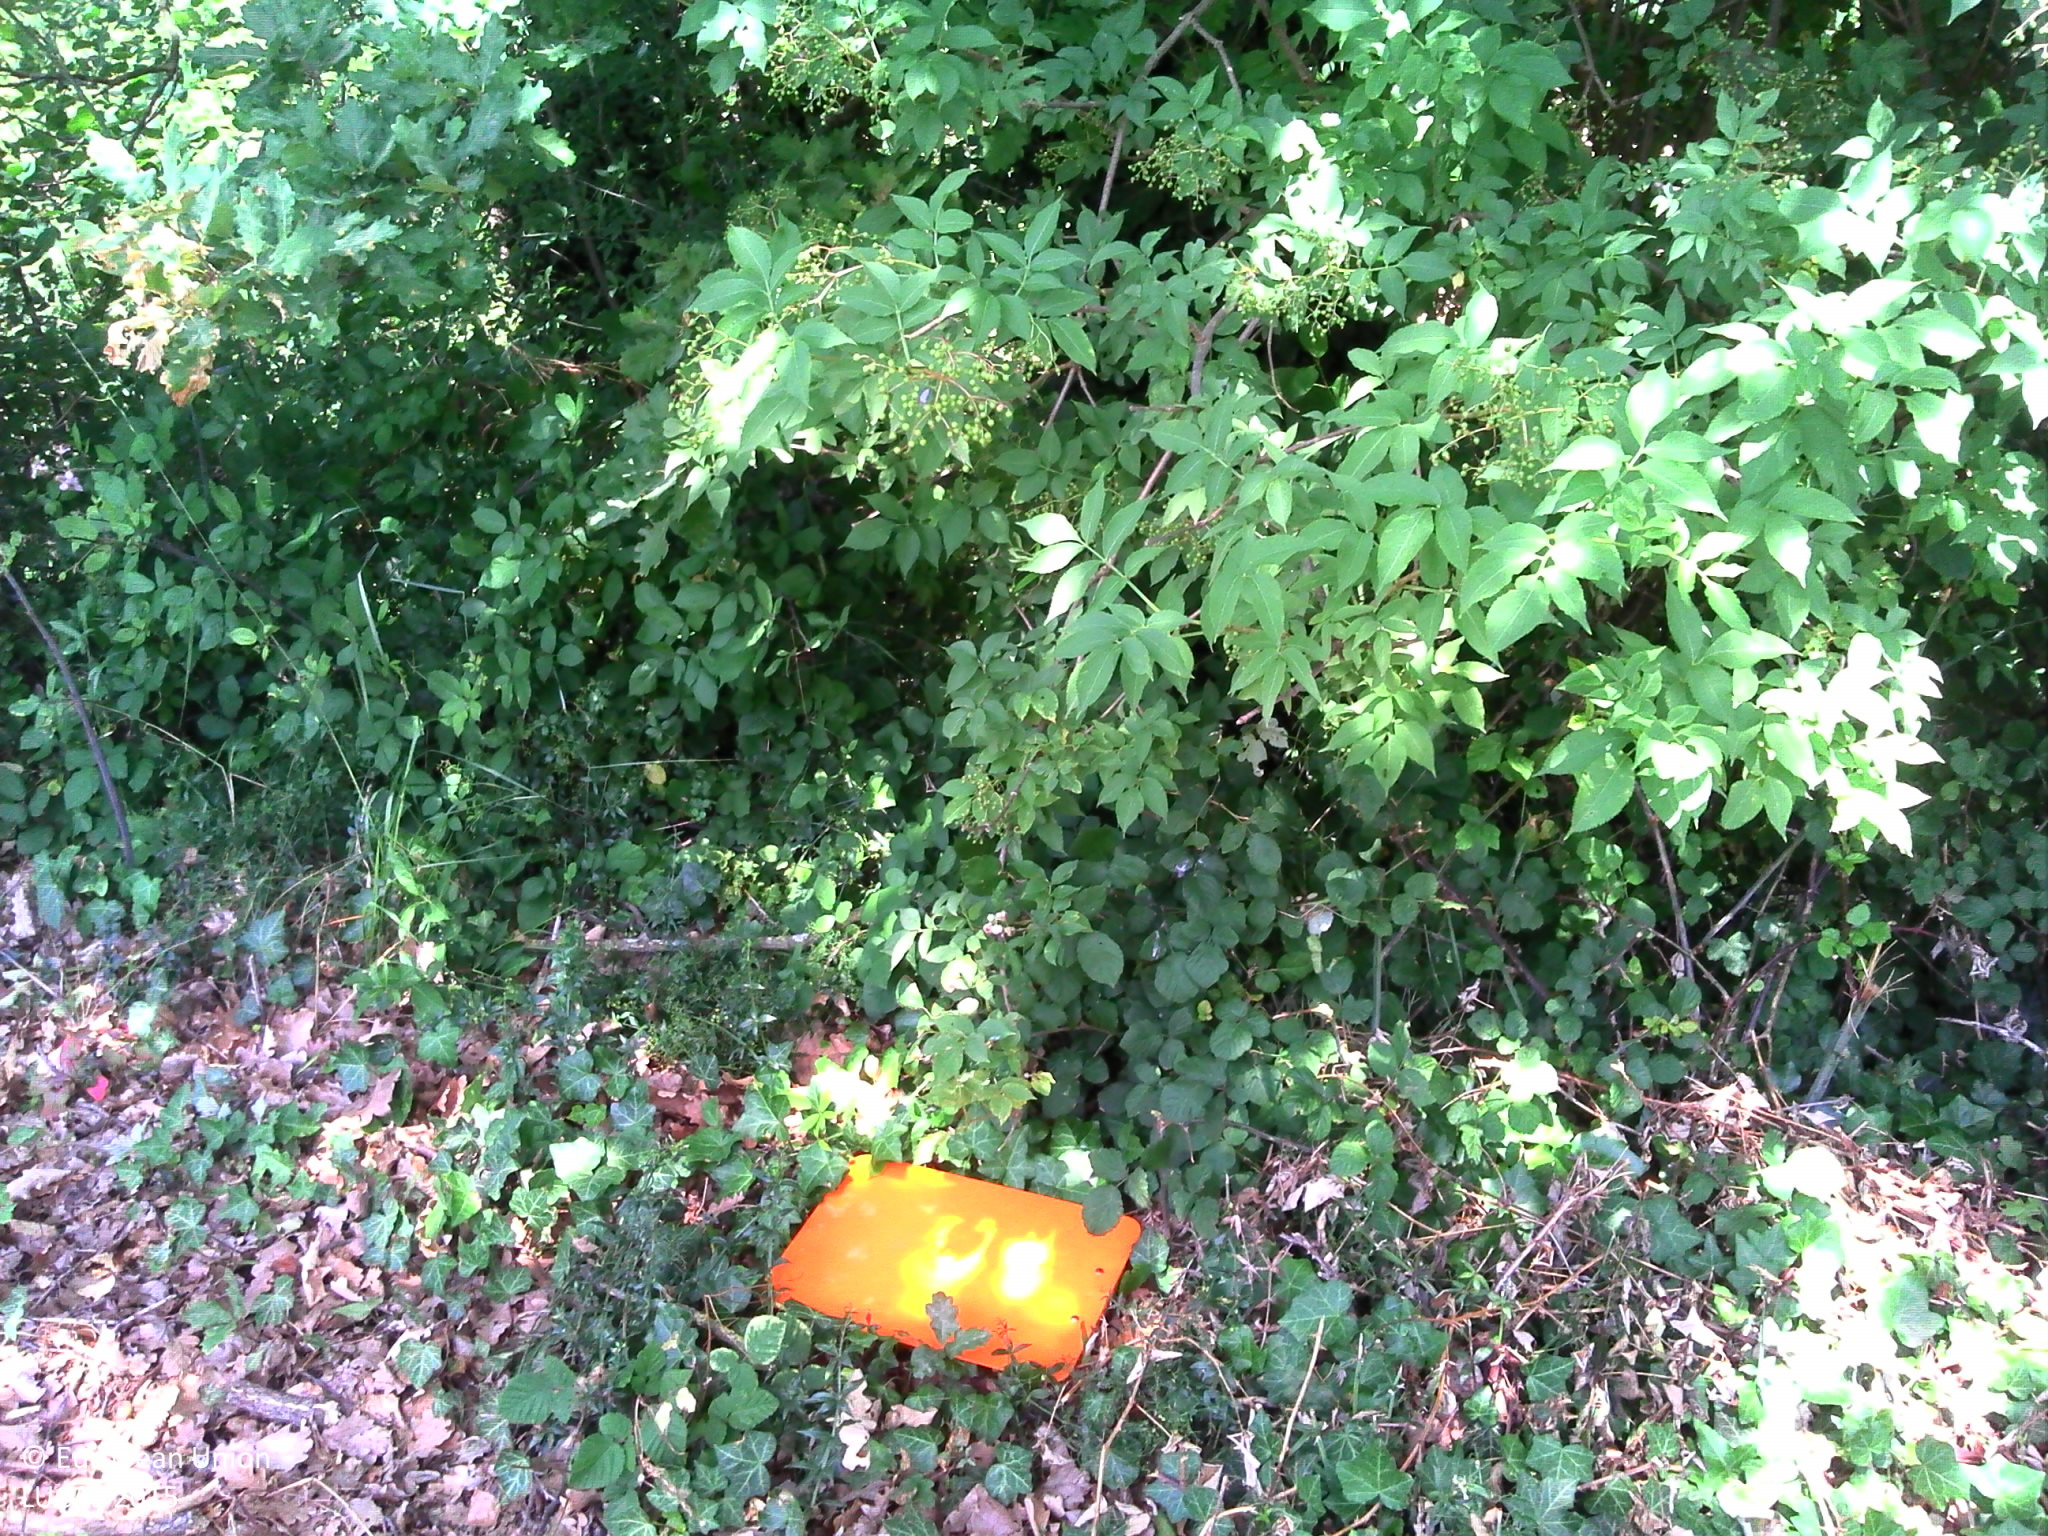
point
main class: Woodland
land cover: Broadleaved woodland
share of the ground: > 75 %
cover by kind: broadleaved forest trees 95 %, herbaceous plants 5 %
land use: Semi-natural and natural areas not in use
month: June
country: FR
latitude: 44.8410
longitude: 4.9330
